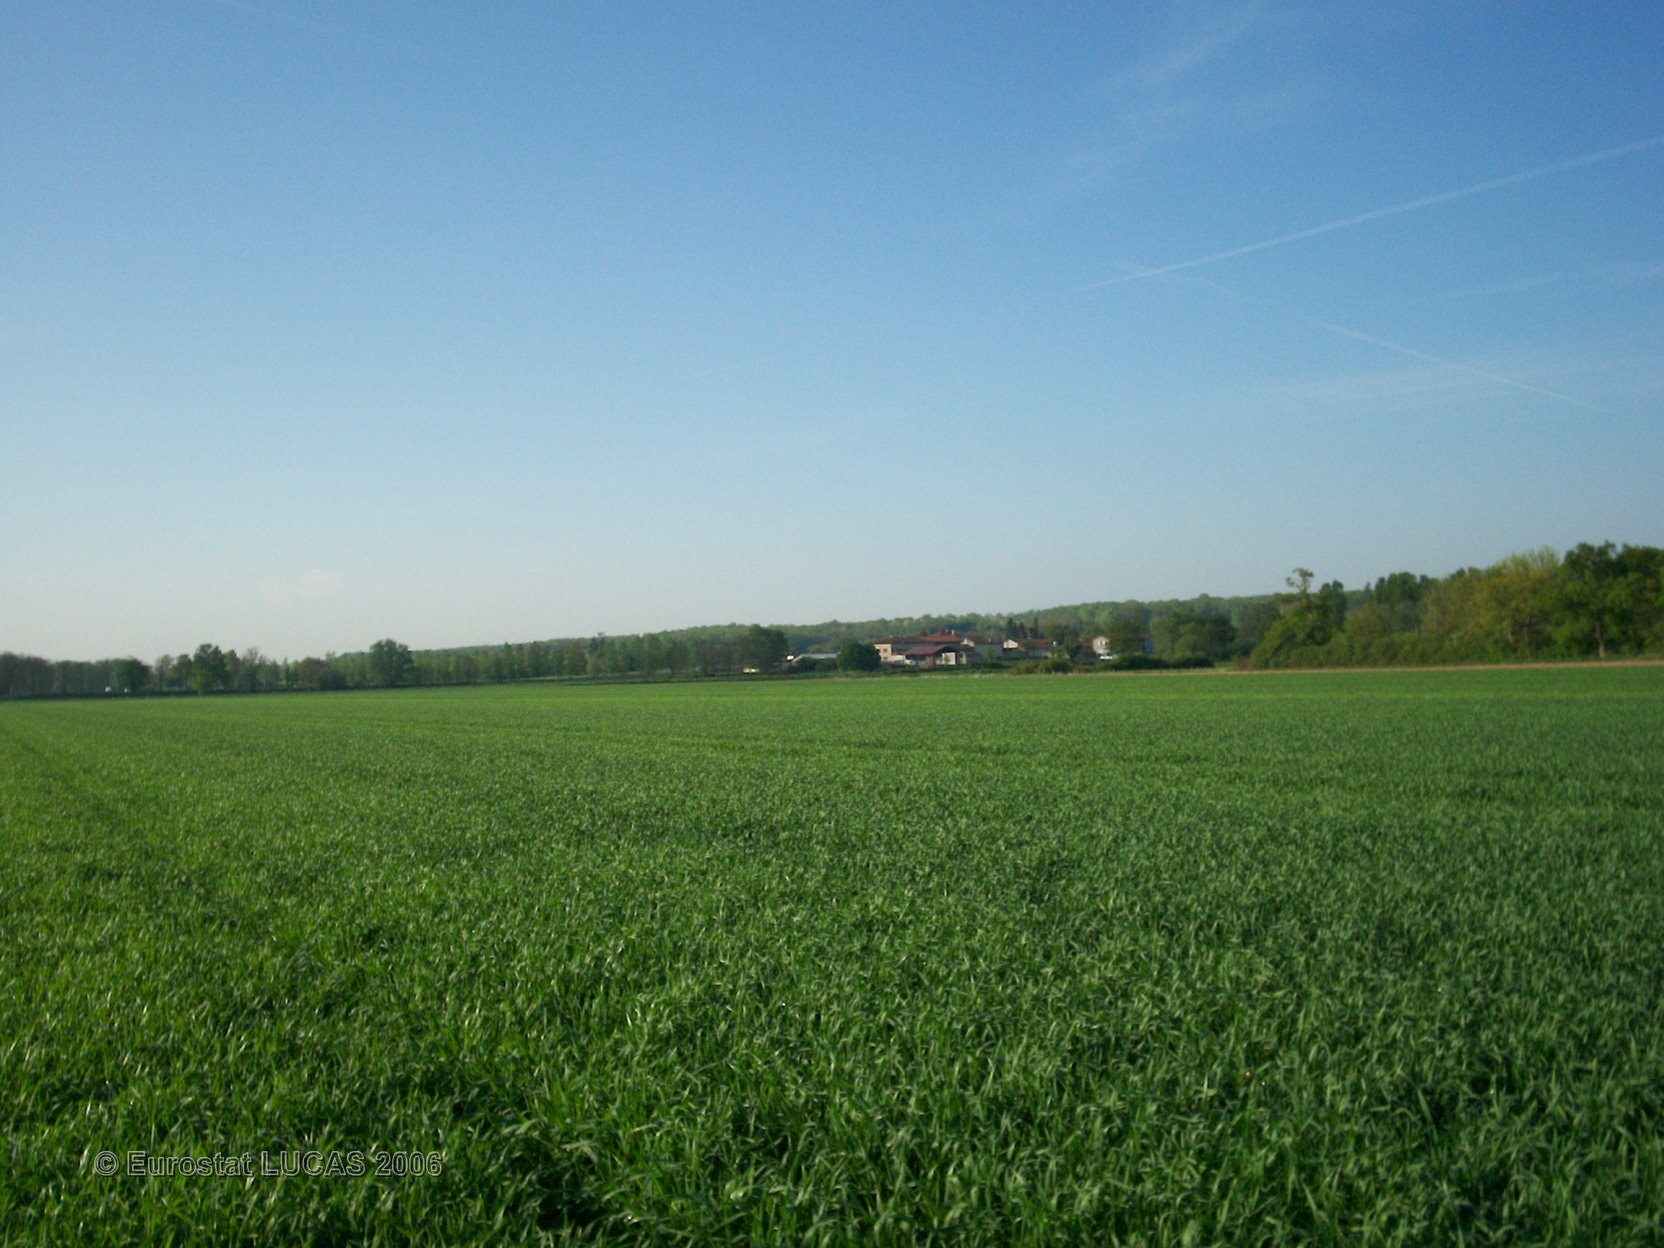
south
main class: Cropland
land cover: Common wheat
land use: Agriculture (excluding fallow land and kitchen gardens)
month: May
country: FR
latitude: 45.7951
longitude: 4.1746
